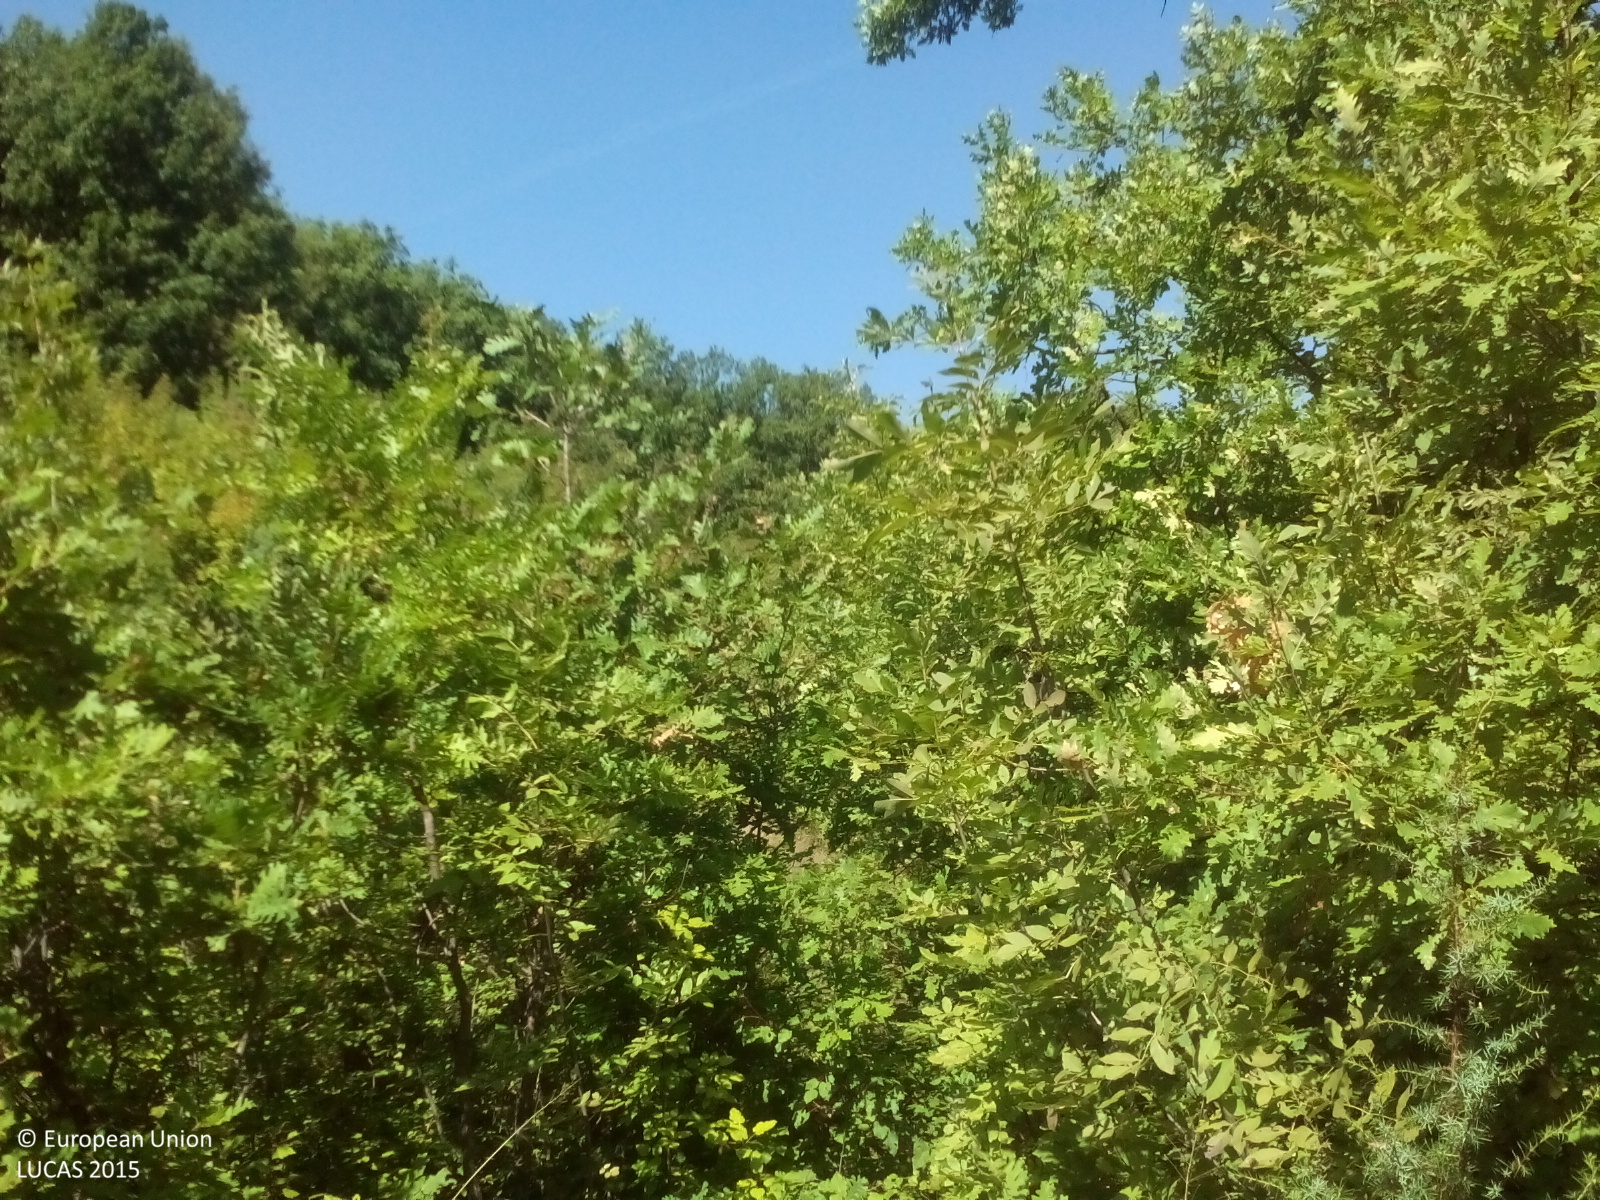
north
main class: Woodland
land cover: Broadleaved woodland
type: thermophilous deciduous forest
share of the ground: 25 - 50 %
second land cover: Grassland without tree/shrub cover
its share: 25 - 50 %
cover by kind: broadleaved forest trees 45 %, herbaceous plants 40 %, unconsolidated bare surface 10 %, shrubs 5 %
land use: Forestry
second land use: Agriculture (excluding fallow land and kitchen gardens)
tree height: > 5 m
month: September
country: GR
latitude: 40.7736
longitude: 21.3555
